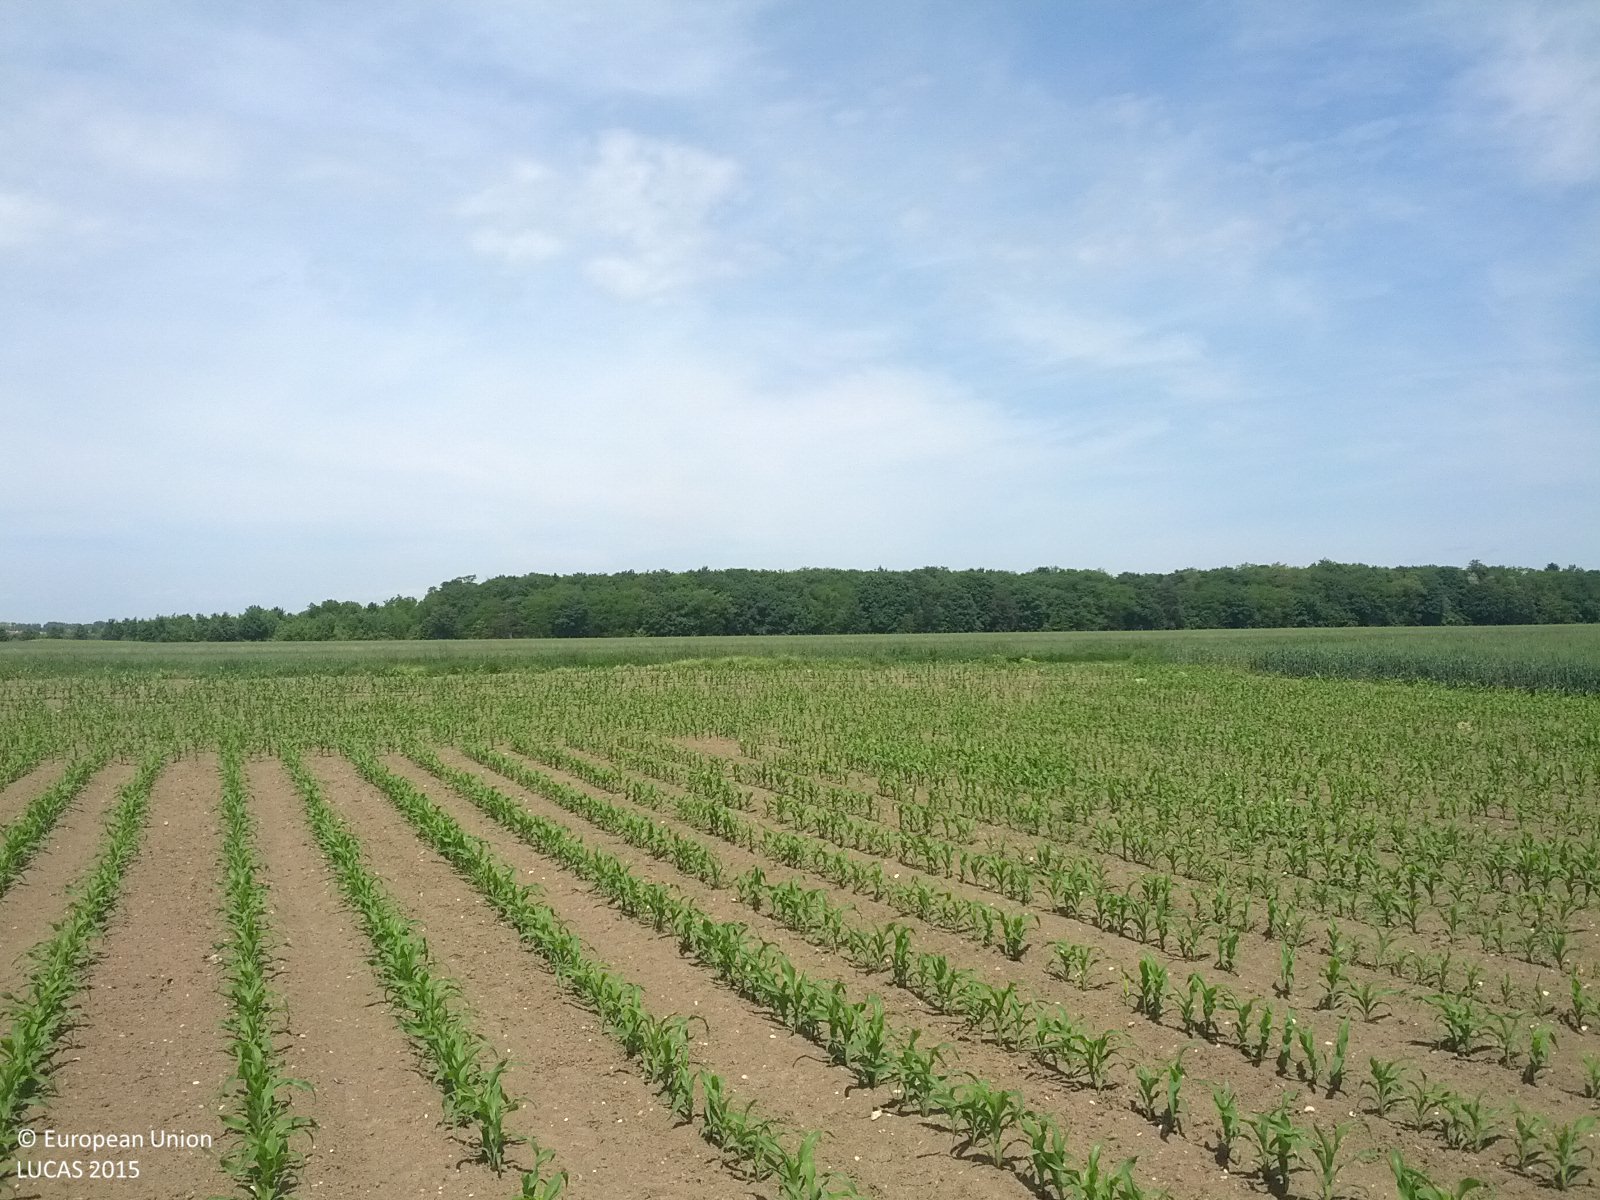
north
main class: Cropland
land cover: Maize
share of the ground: 10 - 25 %
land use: Agriculture (excluding fallow land and kitchen gardens)
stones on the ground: < 10 %
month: May
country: AT
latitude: 48.3096
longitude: 16.0581
